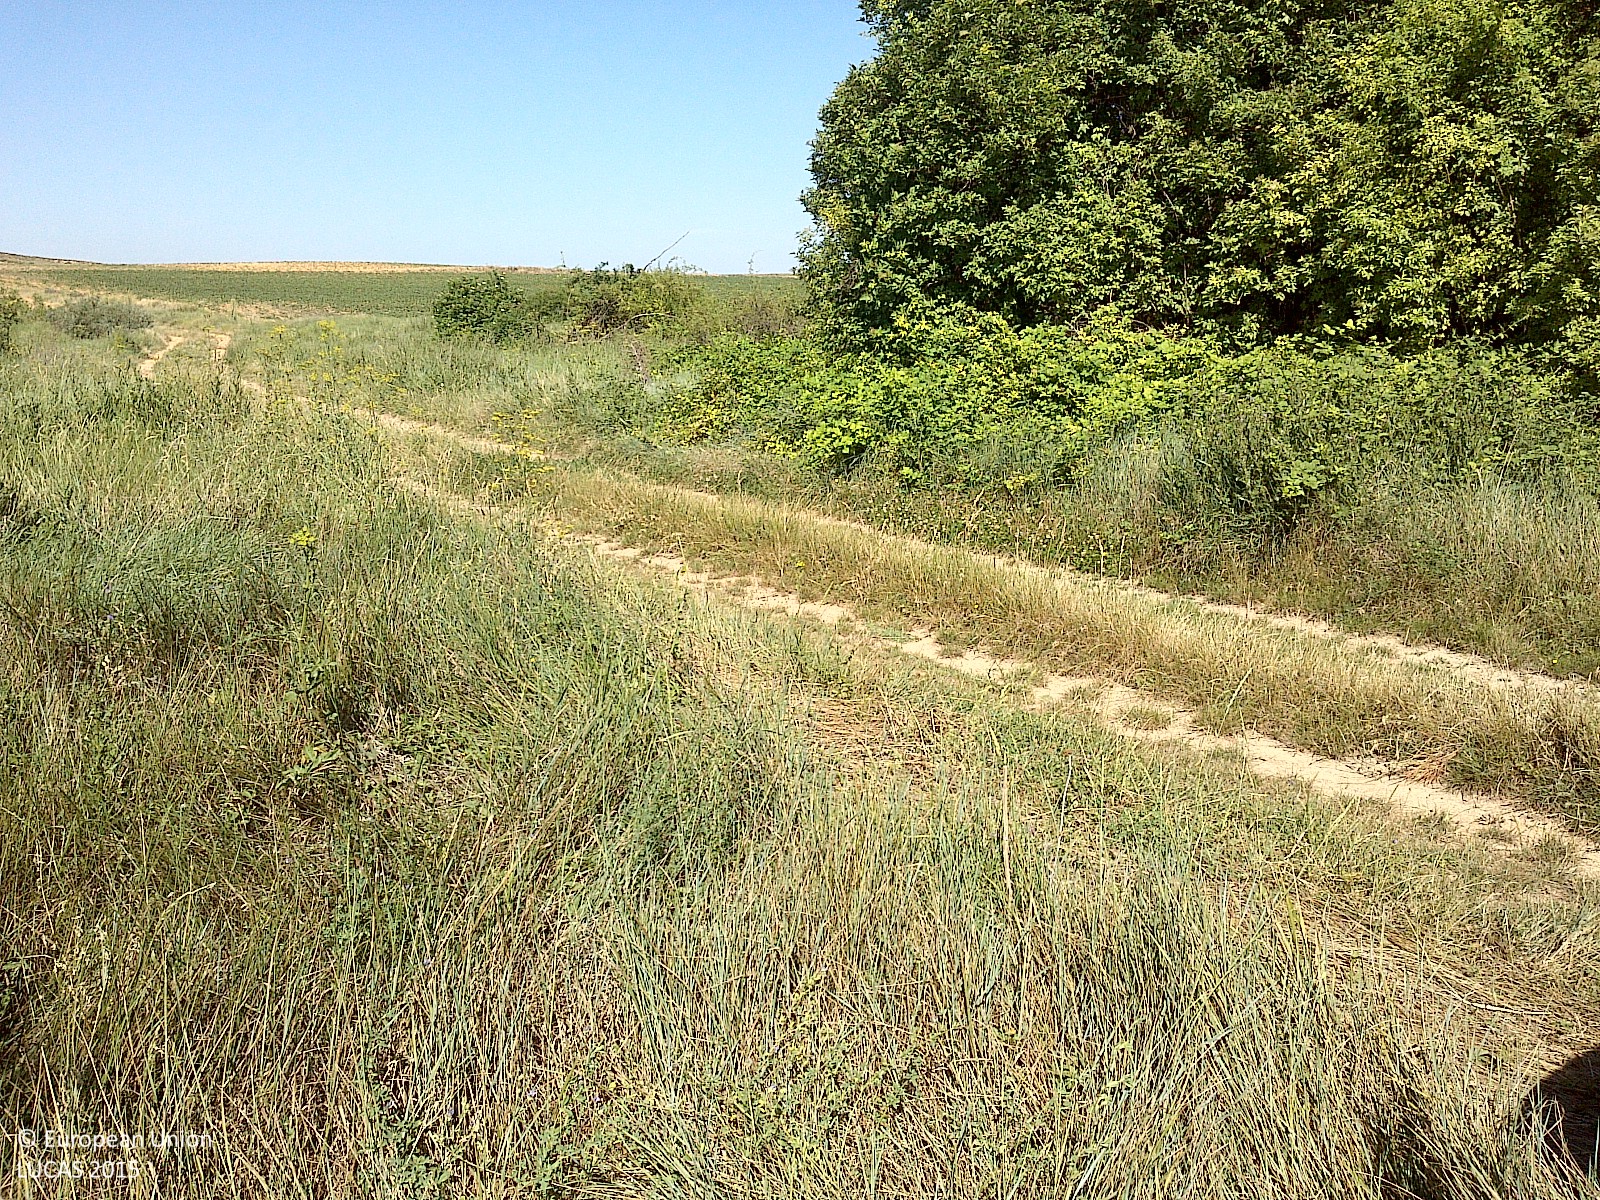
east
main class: Grassland
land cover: Spontaneously vegetated surfaces
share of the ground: > 75 %
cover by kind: herbaceous plants 95 %, shrubs 5 %
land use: Semi-natural and natural areas not in use
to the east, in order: Spontaneously vegetated surfaces; Tracks; Shruby margins; Broadleaved woodland; Sunflower; Grass margins; Rivers and streams; Single bushes/trees; Grass margins; Sunflower
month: July
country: ES
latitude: 41.6046
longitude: -2.7705
